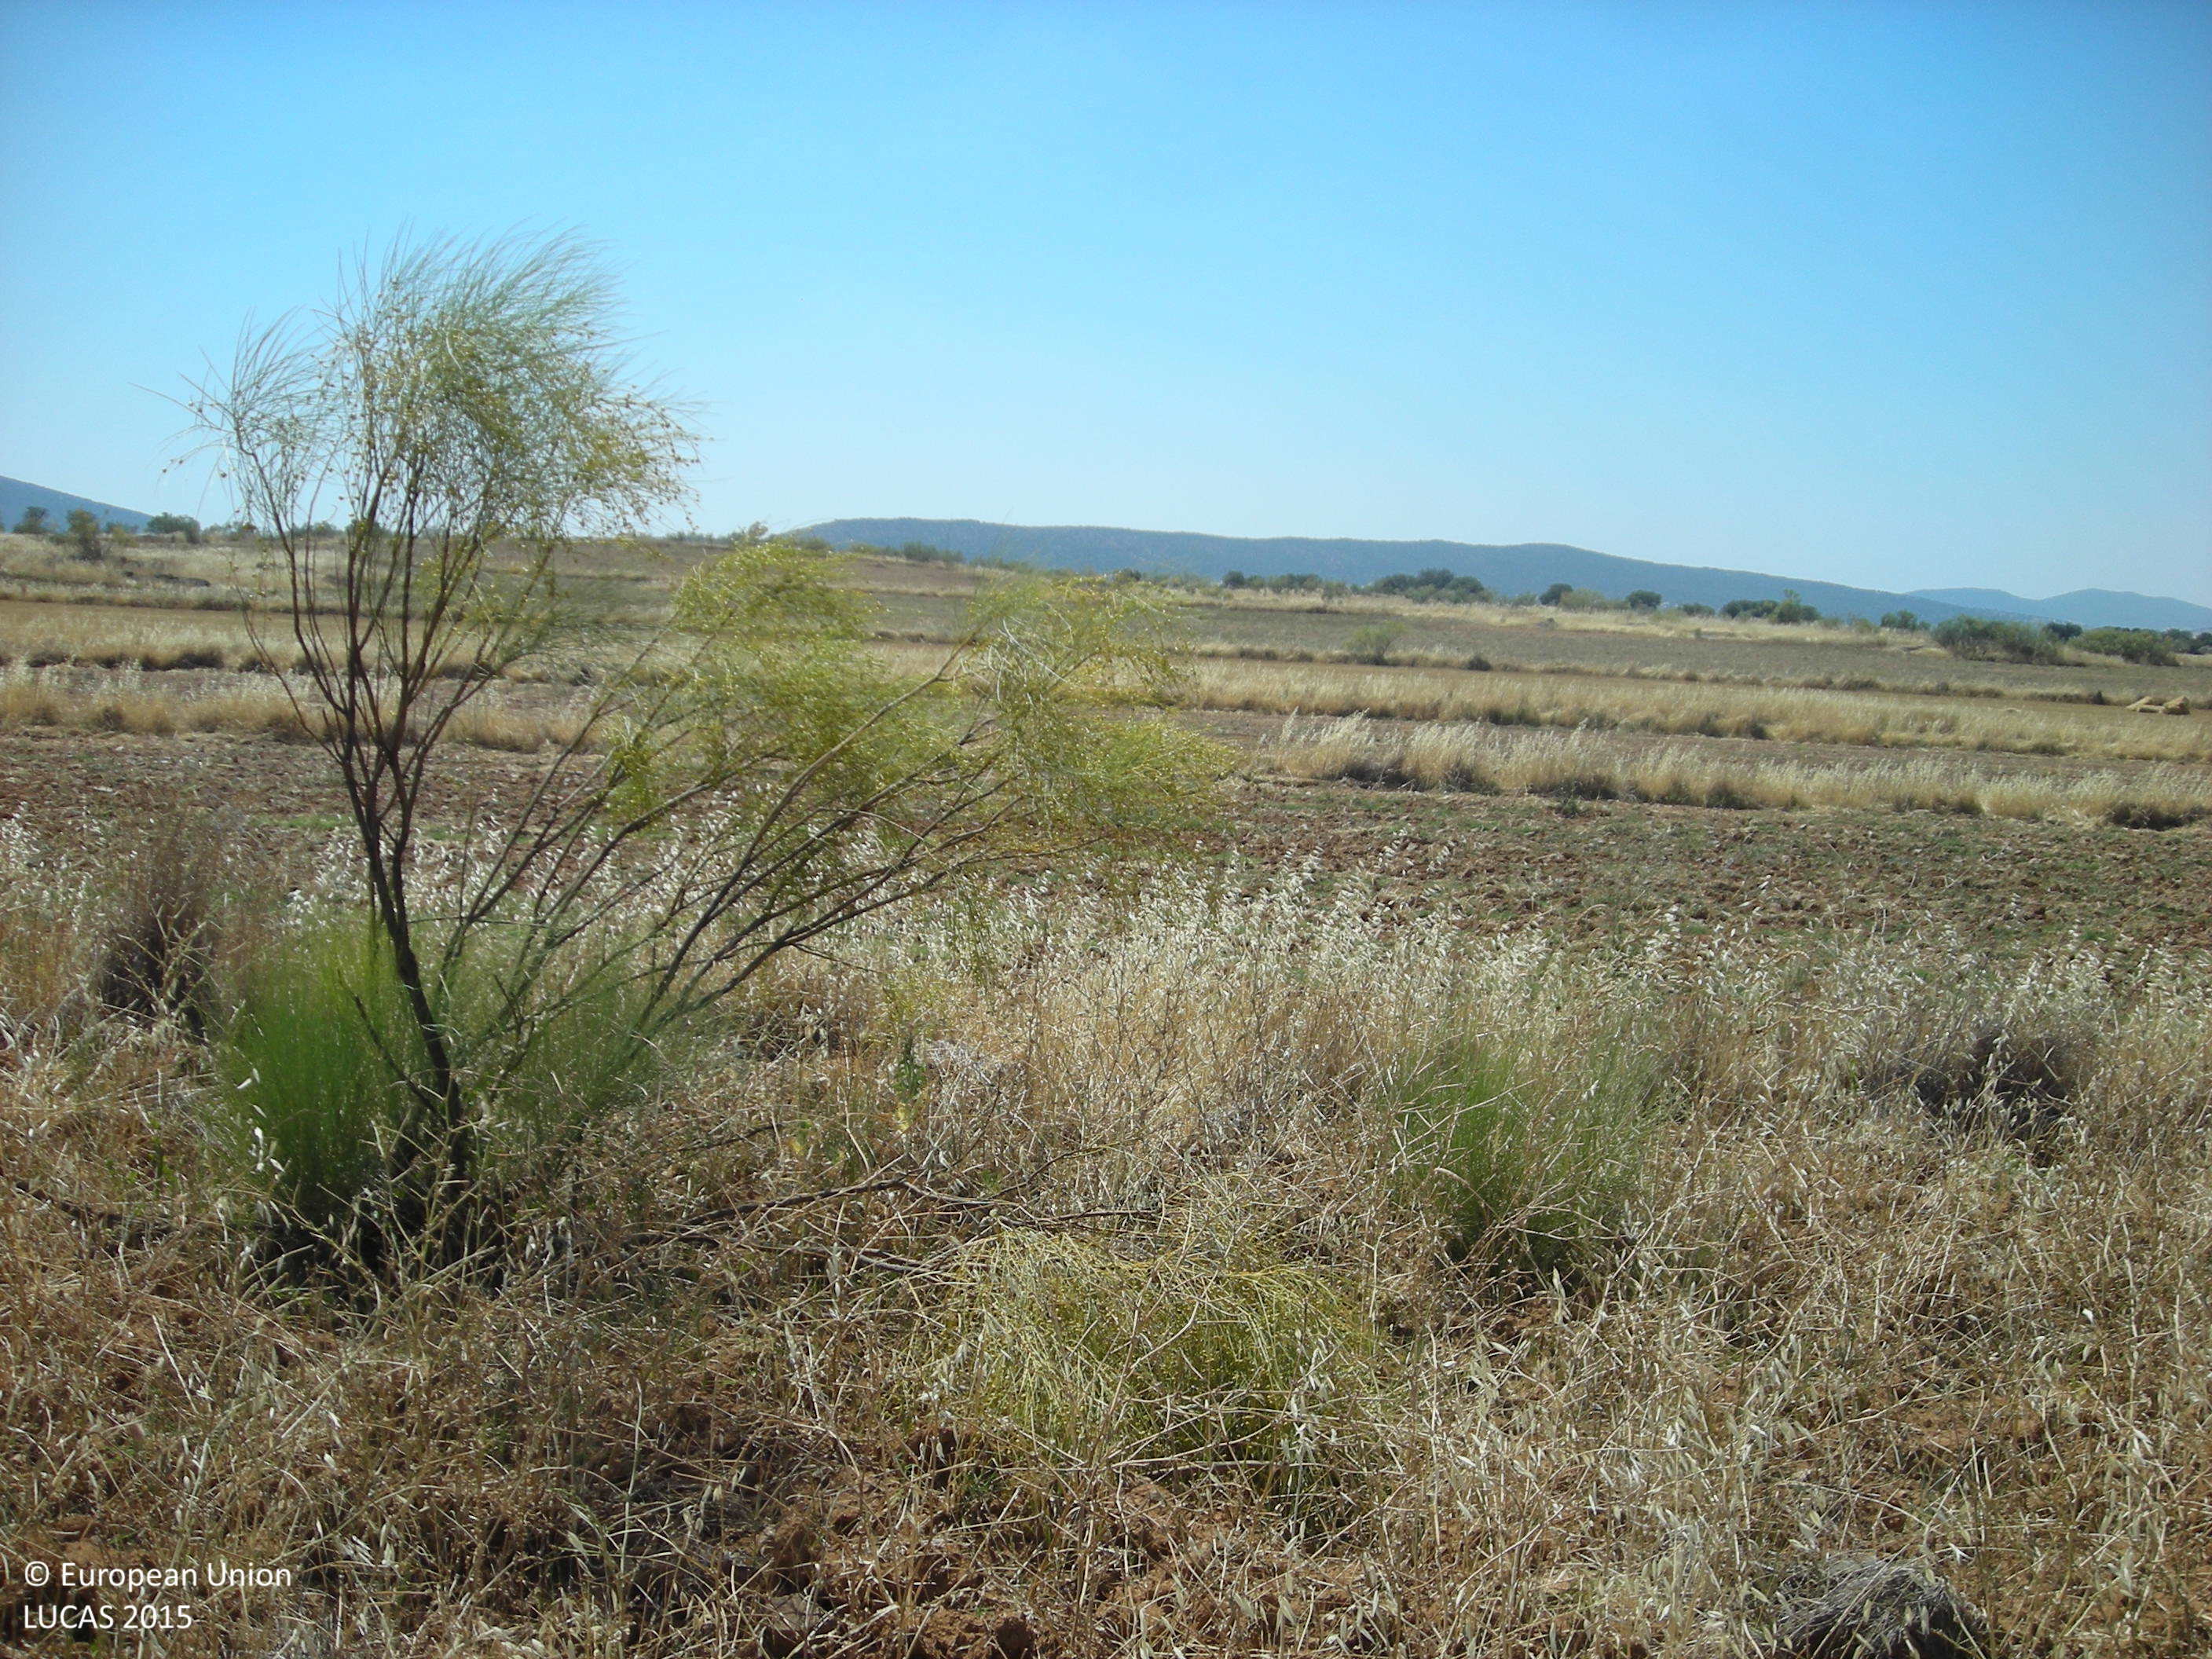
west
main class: Grassland
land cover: Grassland without tree/shrub cover
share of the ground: > 75 %
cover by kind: herbaceous plants 100 %
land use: Agriculture (excluding fallow land and kitchen gardens)
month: June
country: ES
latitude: 38.6512
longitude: -5.7730
